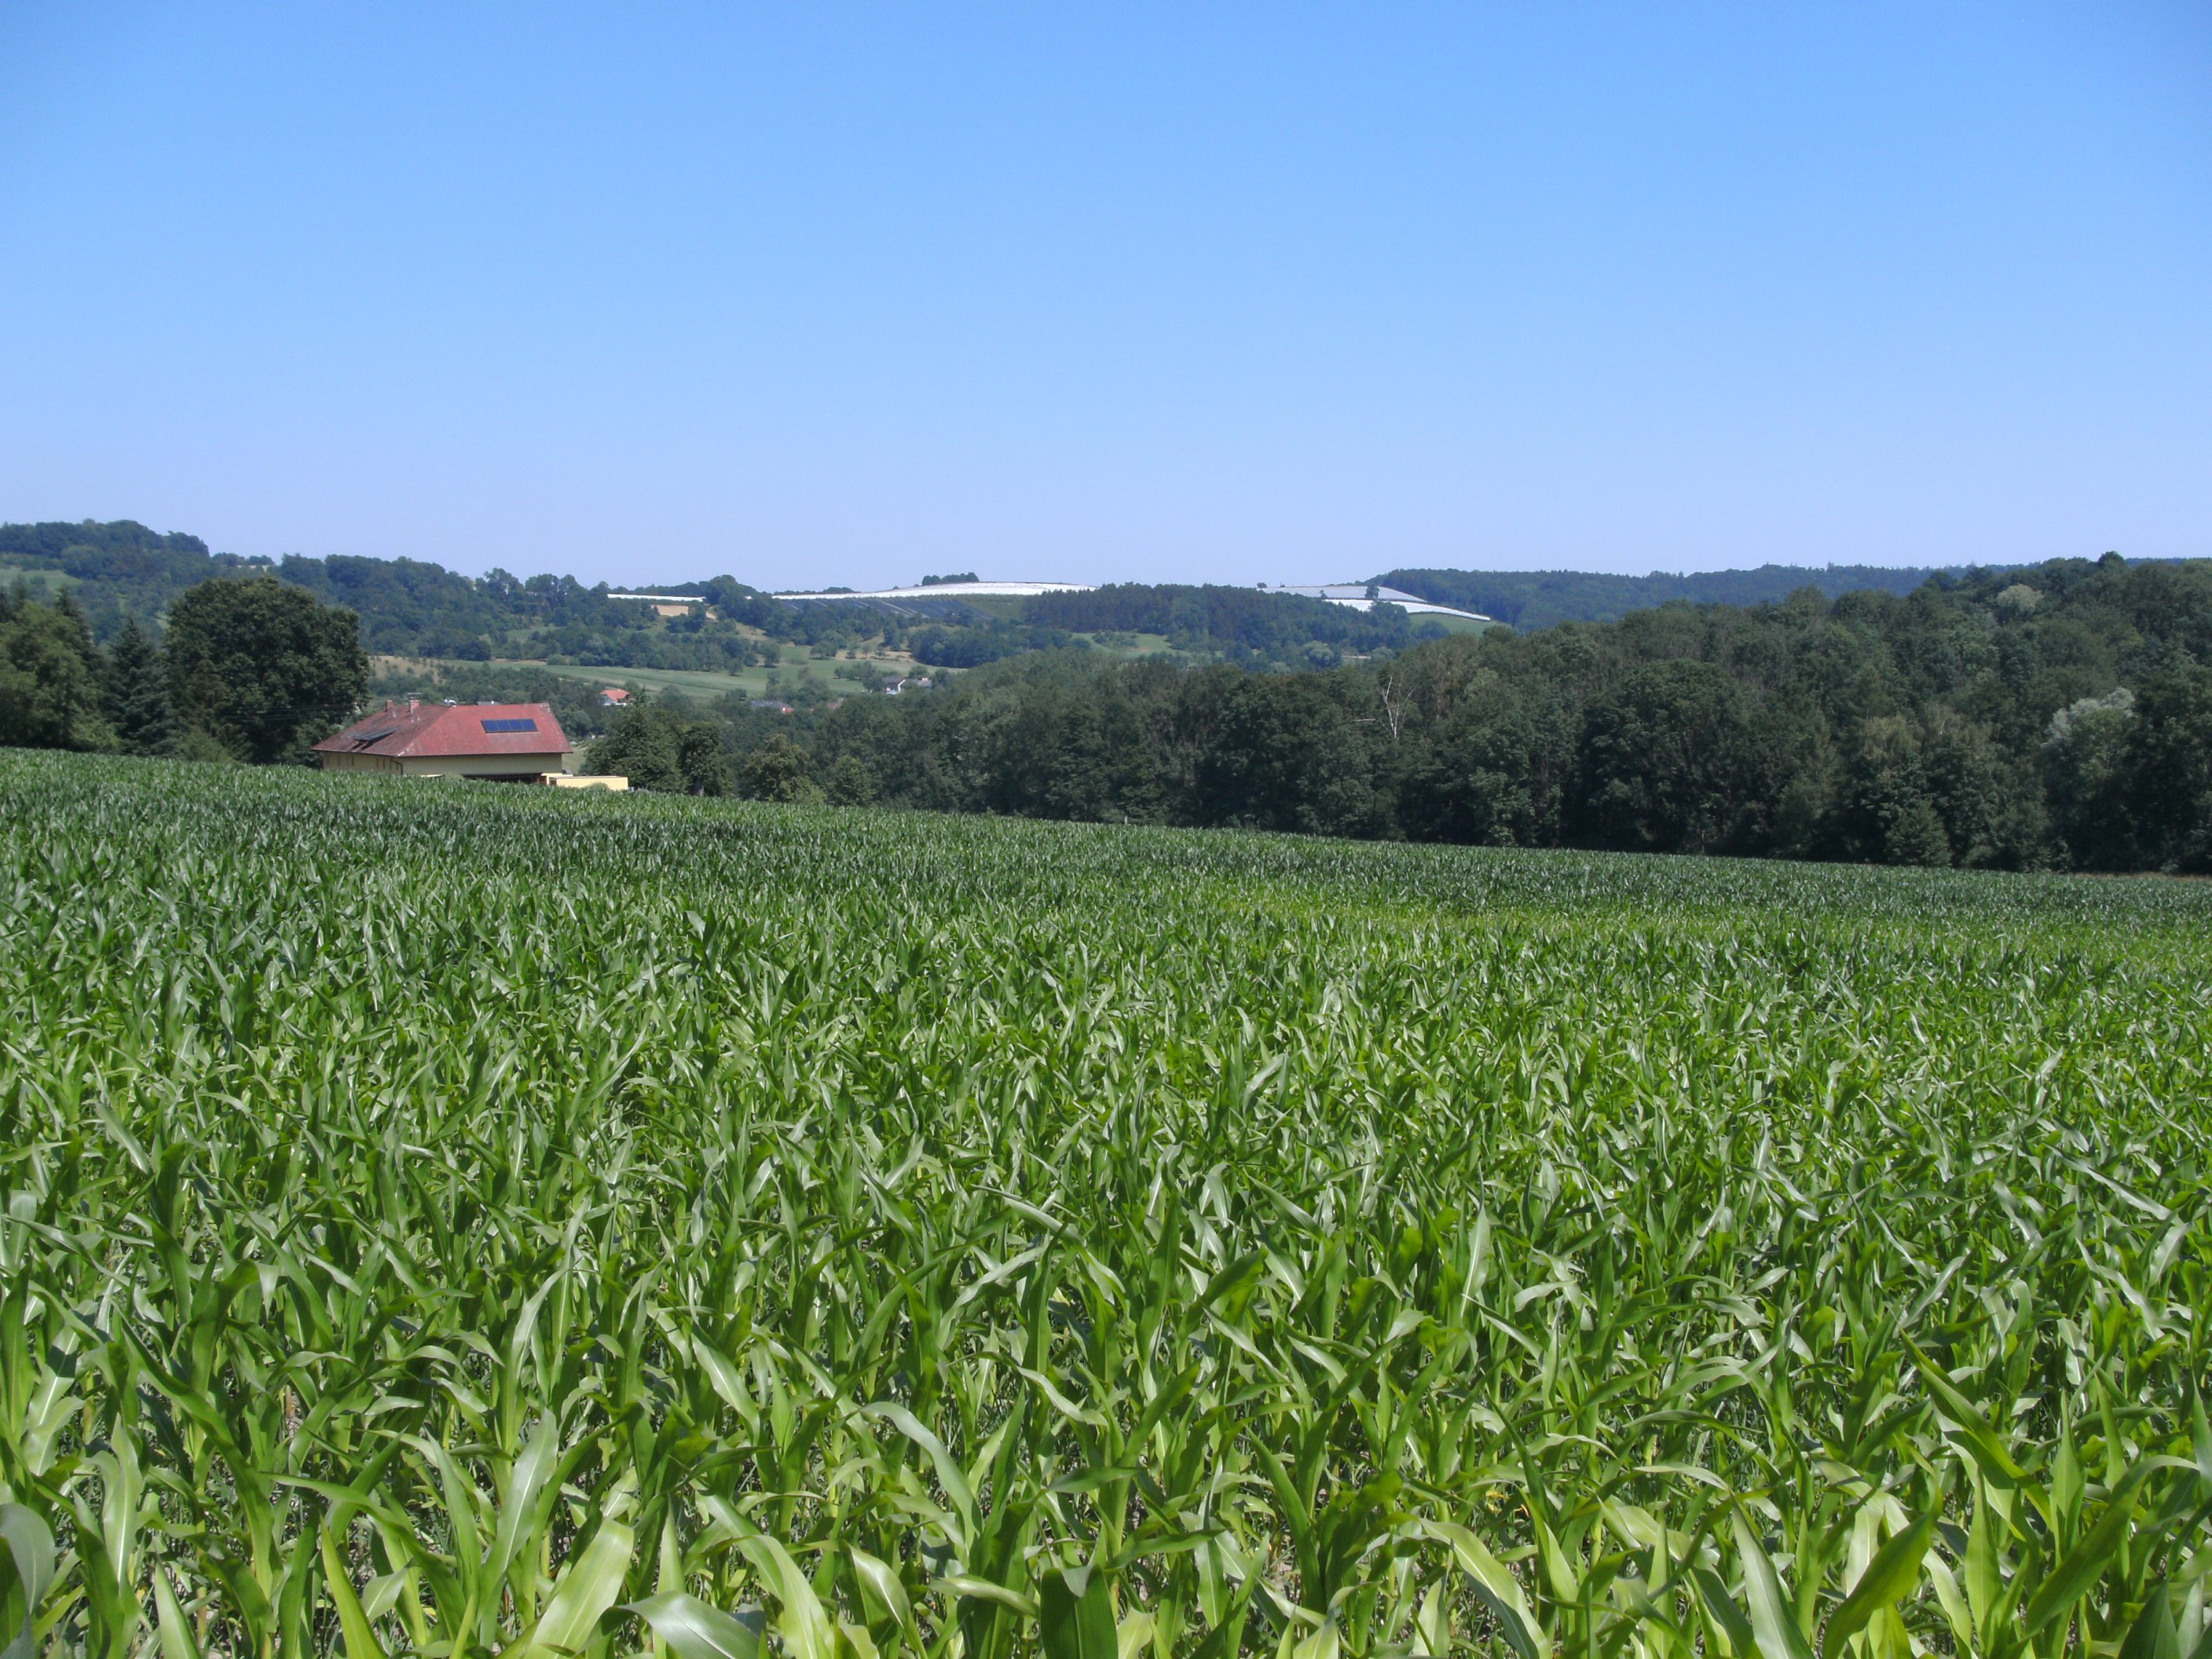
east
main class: Cropland
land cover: Maize
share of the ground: 50 - 75 %
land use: Agriculture (excluding fallow land and kitchen gardens)
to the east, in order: Maize; Grassland without tree/shrub cover; Paved roads, cycling and walking lanes; Grass margins; Maize
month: July
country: AT
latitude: 48.2581
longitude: 14.0272
